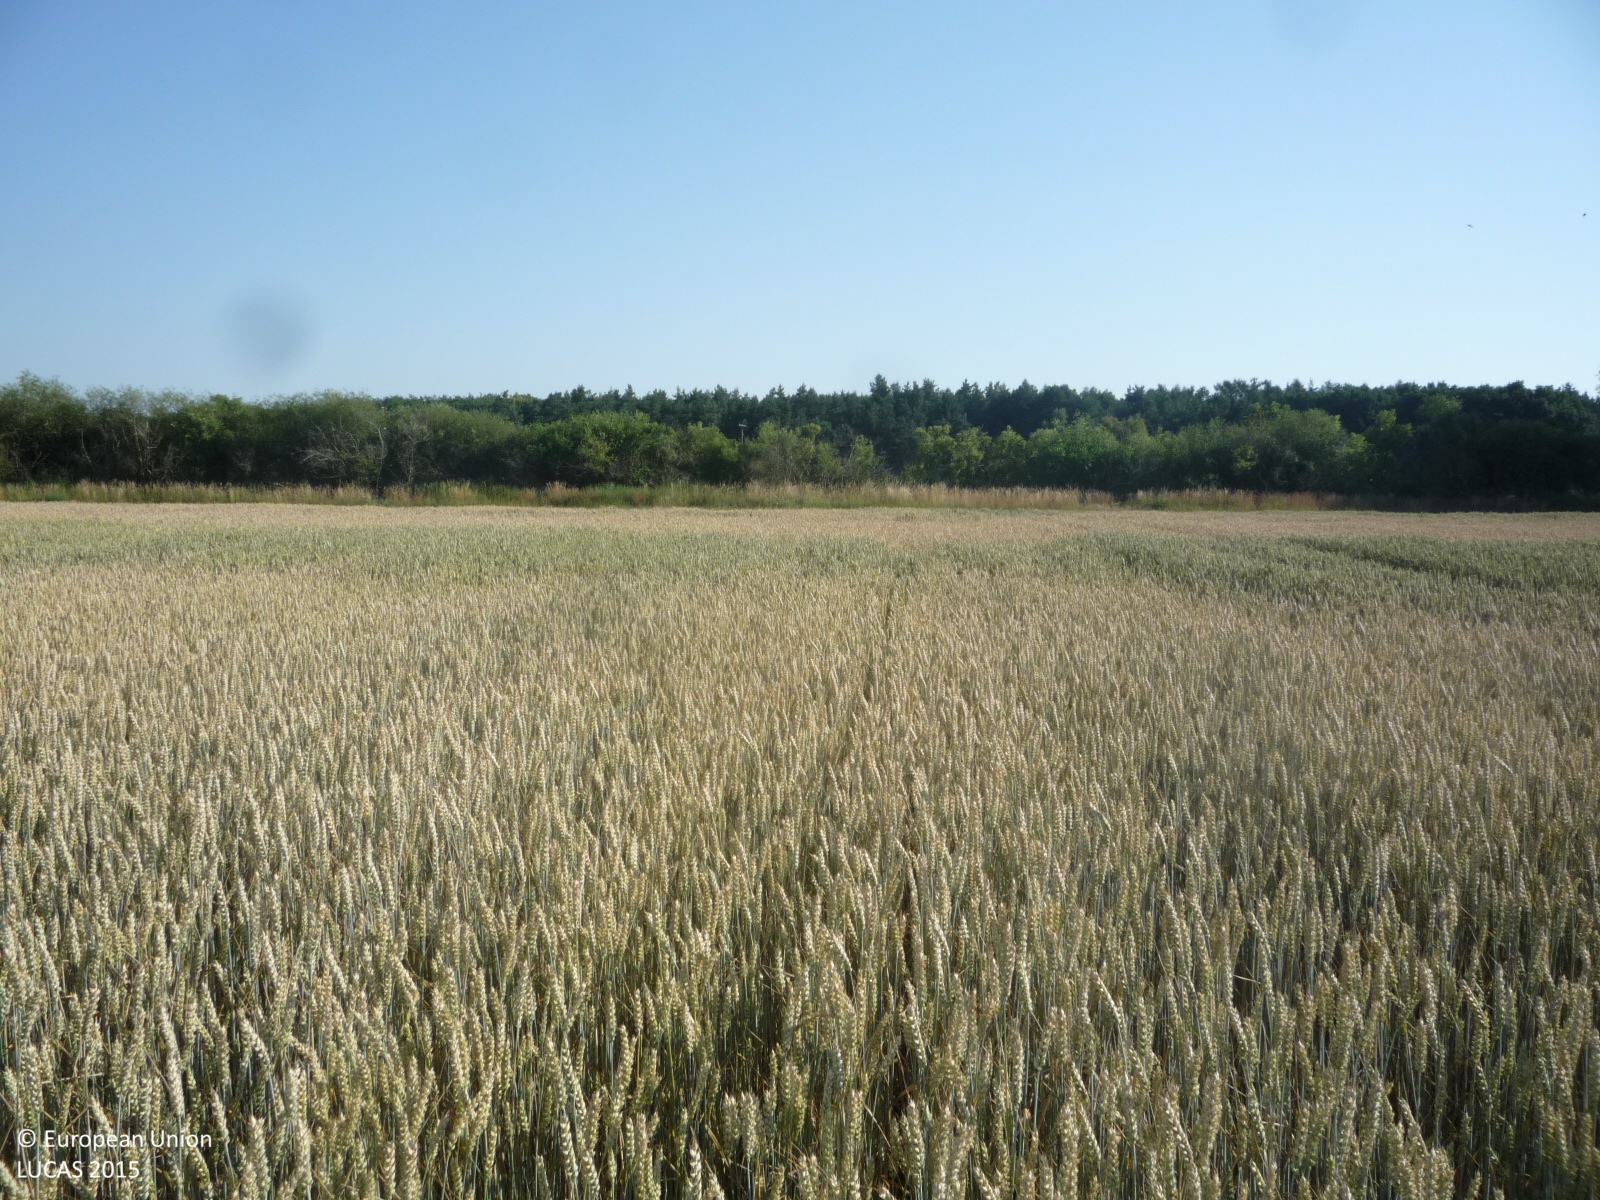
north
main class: Cropland
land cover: Common wheat
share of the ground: > 75 %
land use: Agriculture (excluding fallow land and kitchen gardens)
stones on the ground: < 10 %
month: July
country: CZ
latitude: 50.1380
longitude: 15.1940
